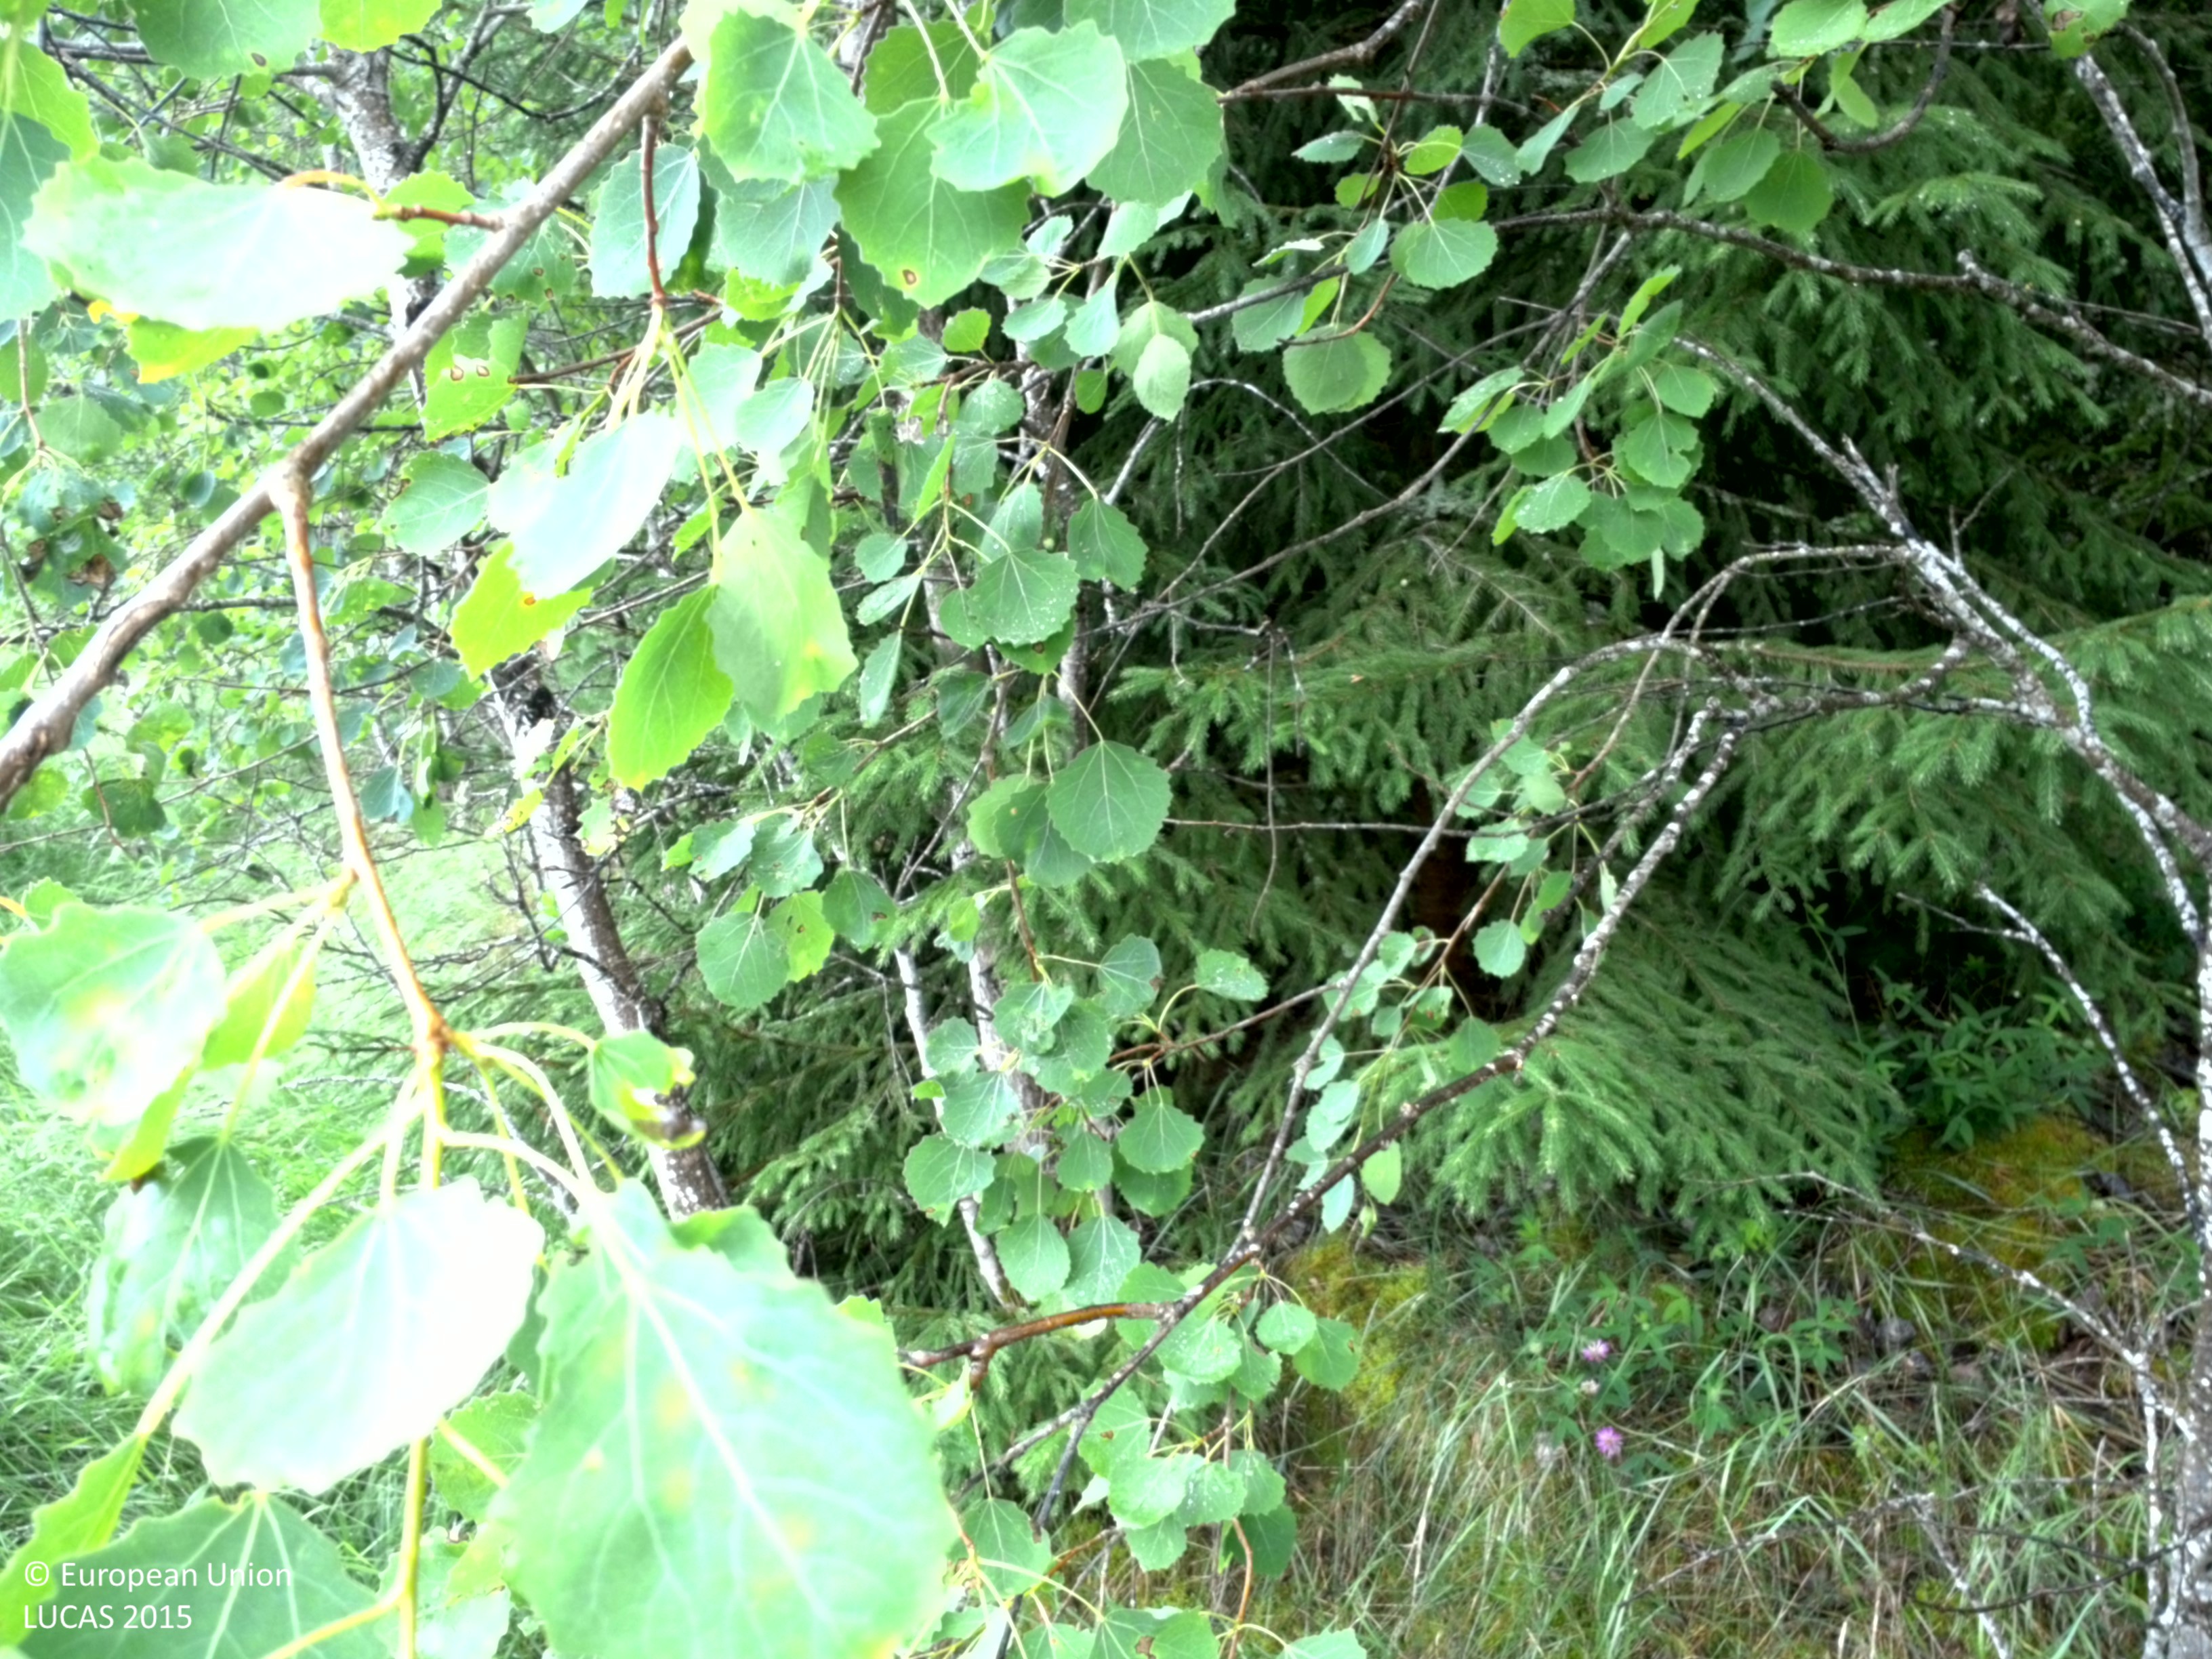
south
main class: Cropland
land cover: Common wheat
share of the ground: > 75 %
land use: Agriculture (excluding fallow land and kitchen gardens)
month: July
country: SE
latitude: 60.1229
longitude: 17.2085
